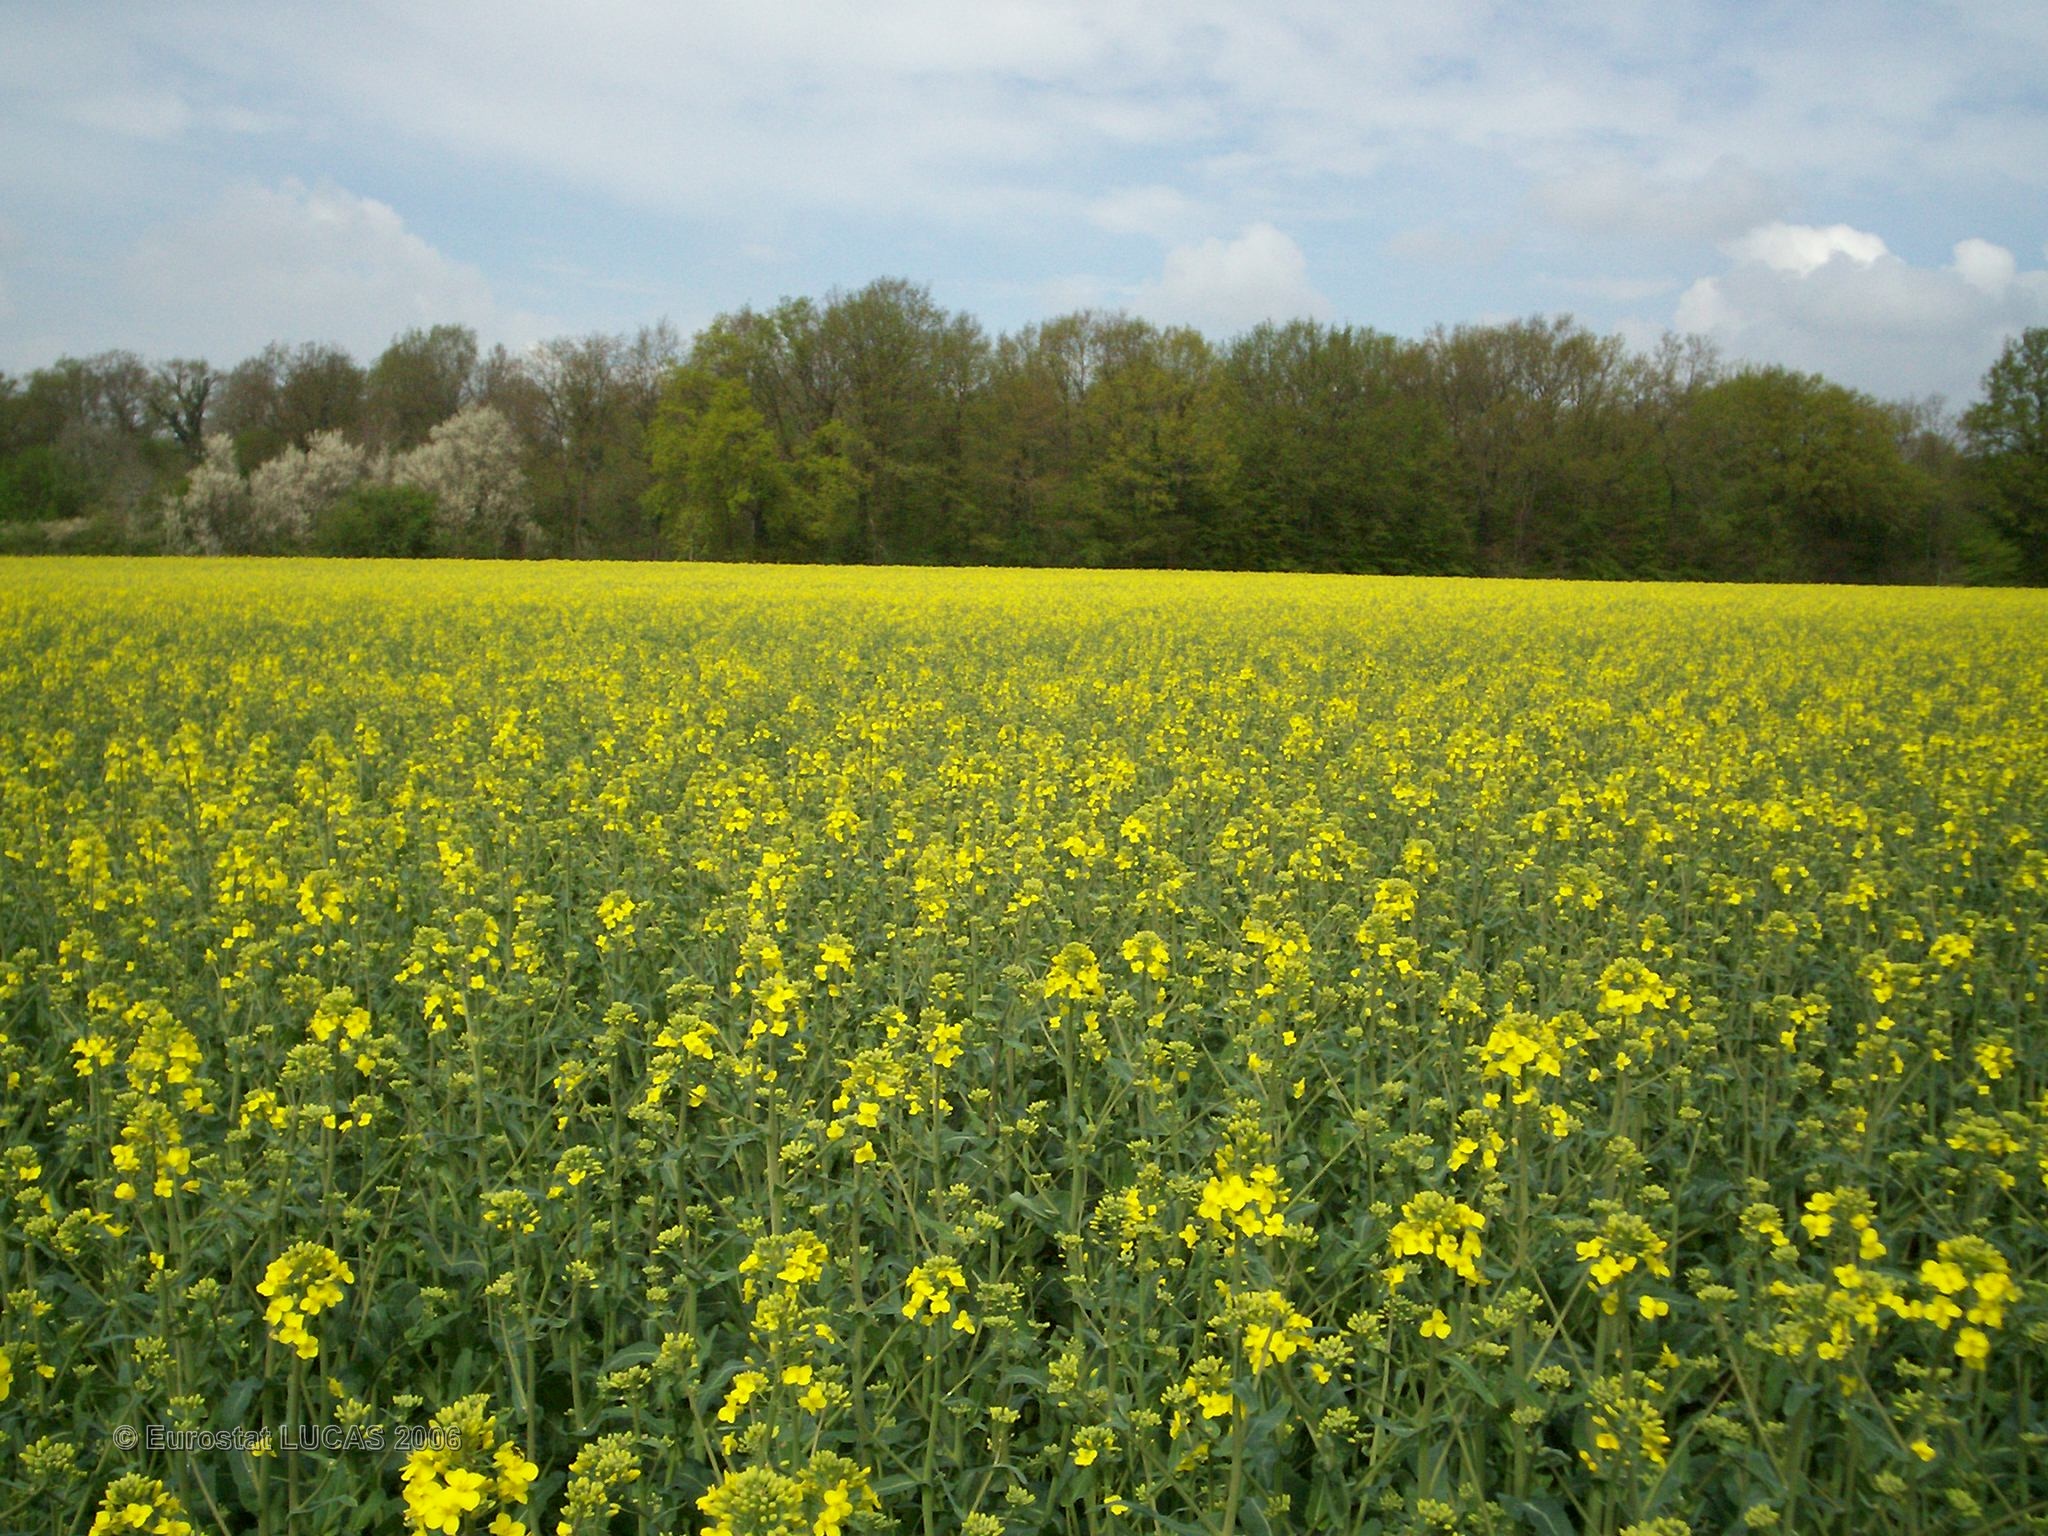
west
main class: Cropland
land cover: Rape and turnip rape
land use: Agriculture (excluding fallow land and kitchen gardens)
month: April
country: FR
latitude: 47.8370
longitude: 2.9789
